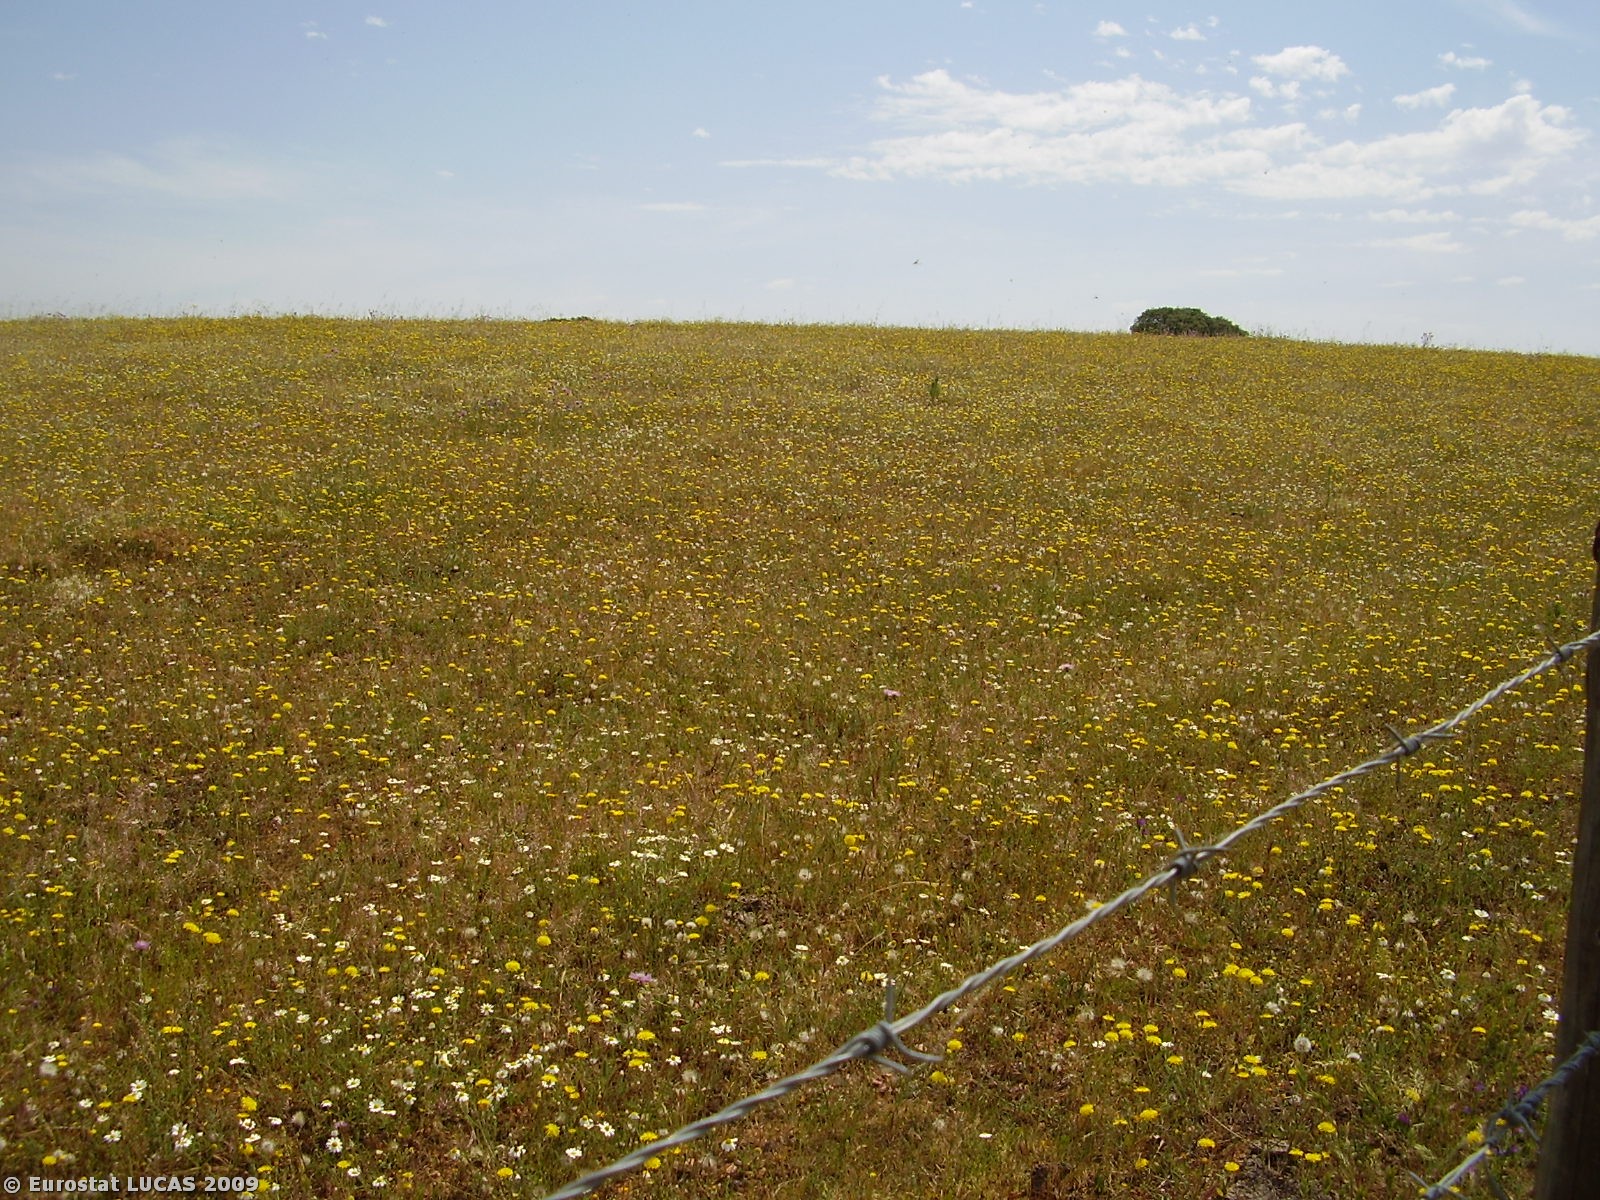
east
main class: Grassland
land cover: Grassland with sparse tree/shrub cover
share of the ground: > 75 %
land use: Agriculture (excluding fallow land and kitchen gardens)
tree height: > 5 m
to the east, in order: Grassland with sparse tree/shrub cover
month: May
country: PT
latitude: 37.9179
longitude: -7.9204
